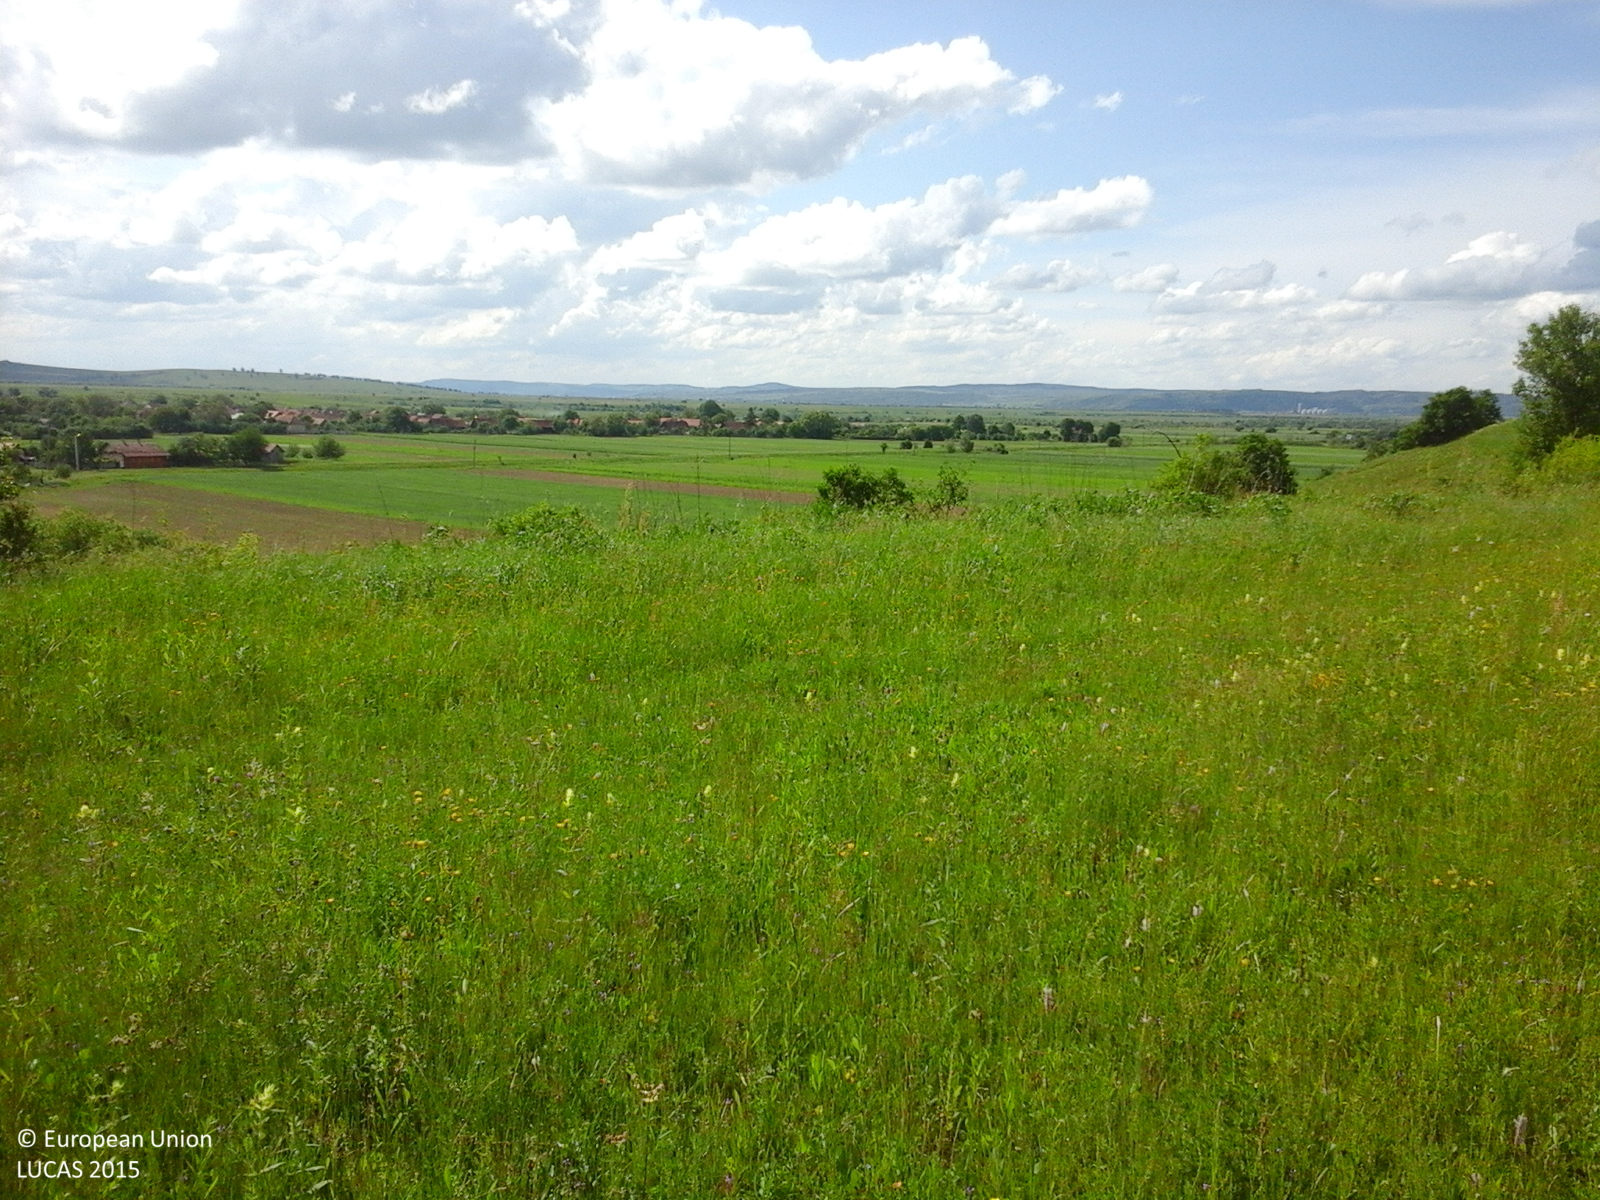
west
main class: Cropland
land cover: Other leguminous and mixtures for fodder
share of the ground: > 75 %
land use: Agriculture (excluding fallow land and kitchen gardens)
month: May
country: RO
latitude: 45.7939
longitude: 25.1603
